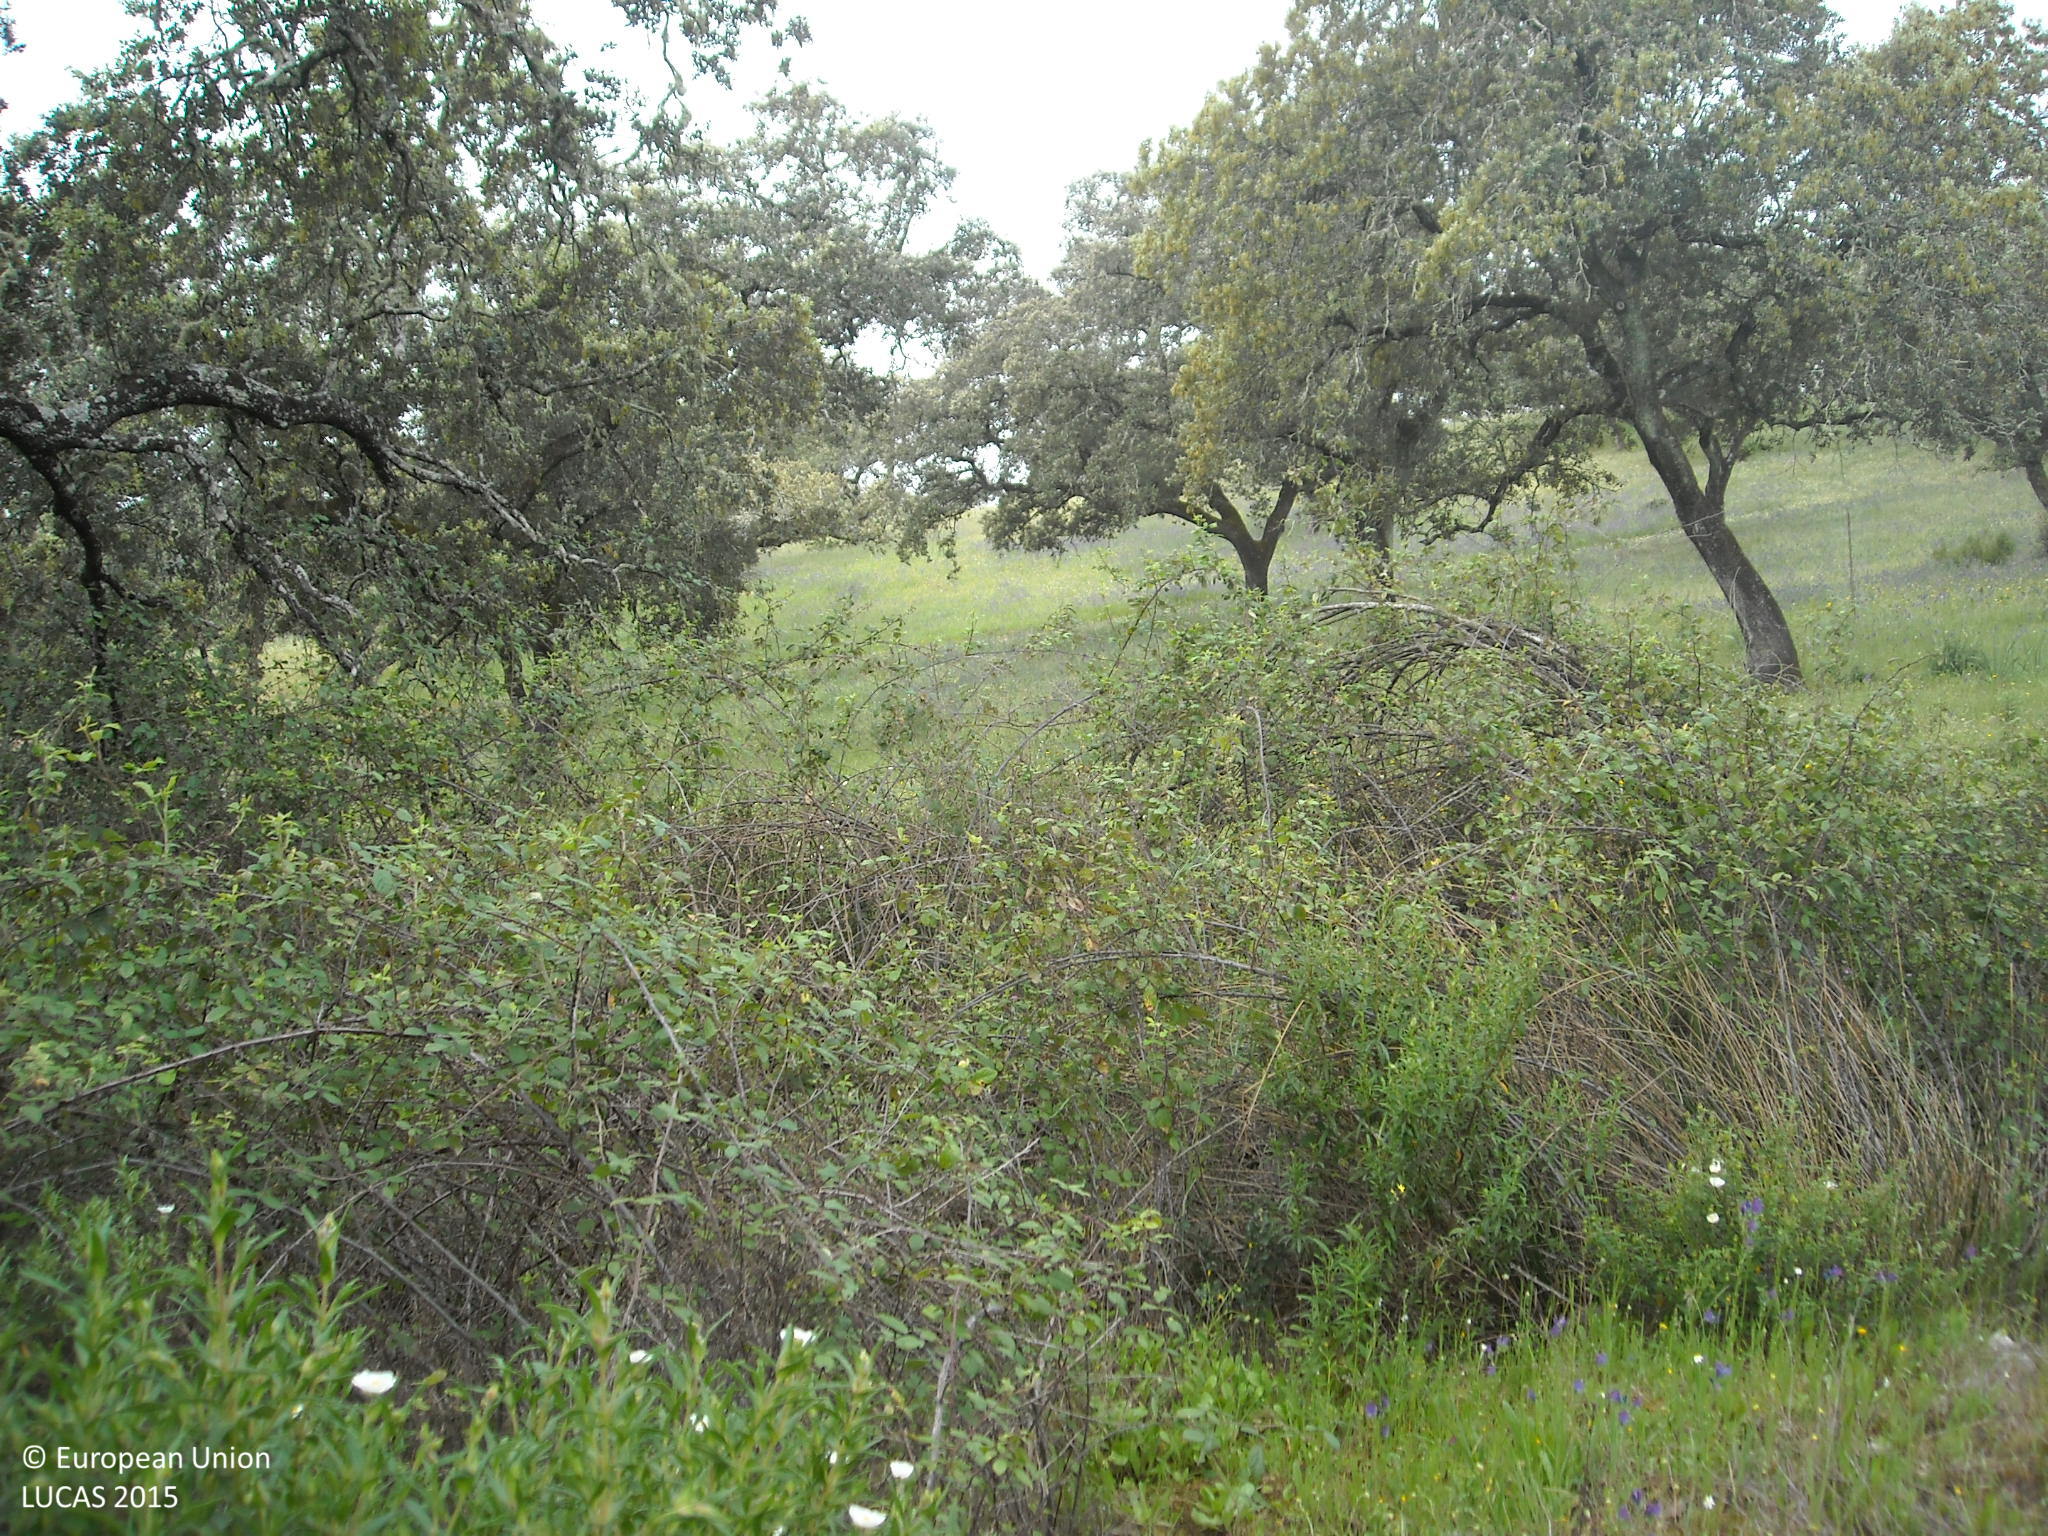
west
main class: Woodland
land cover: Broadleaved woodland
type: broadleaved evergreen forest
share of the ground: 50 - 75 %
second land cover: Shrubland without tree cover
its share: 10 - 25 %
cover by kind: broadleaved forest trees 60 %, shrubs 20 %, herbaceous plants 20 %
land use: Forestry
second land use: Agriculture (excluding fallow land and kitchen gardens)
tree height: > 5 m
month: April
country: ES
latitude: 37.7528
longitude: -6.1848
